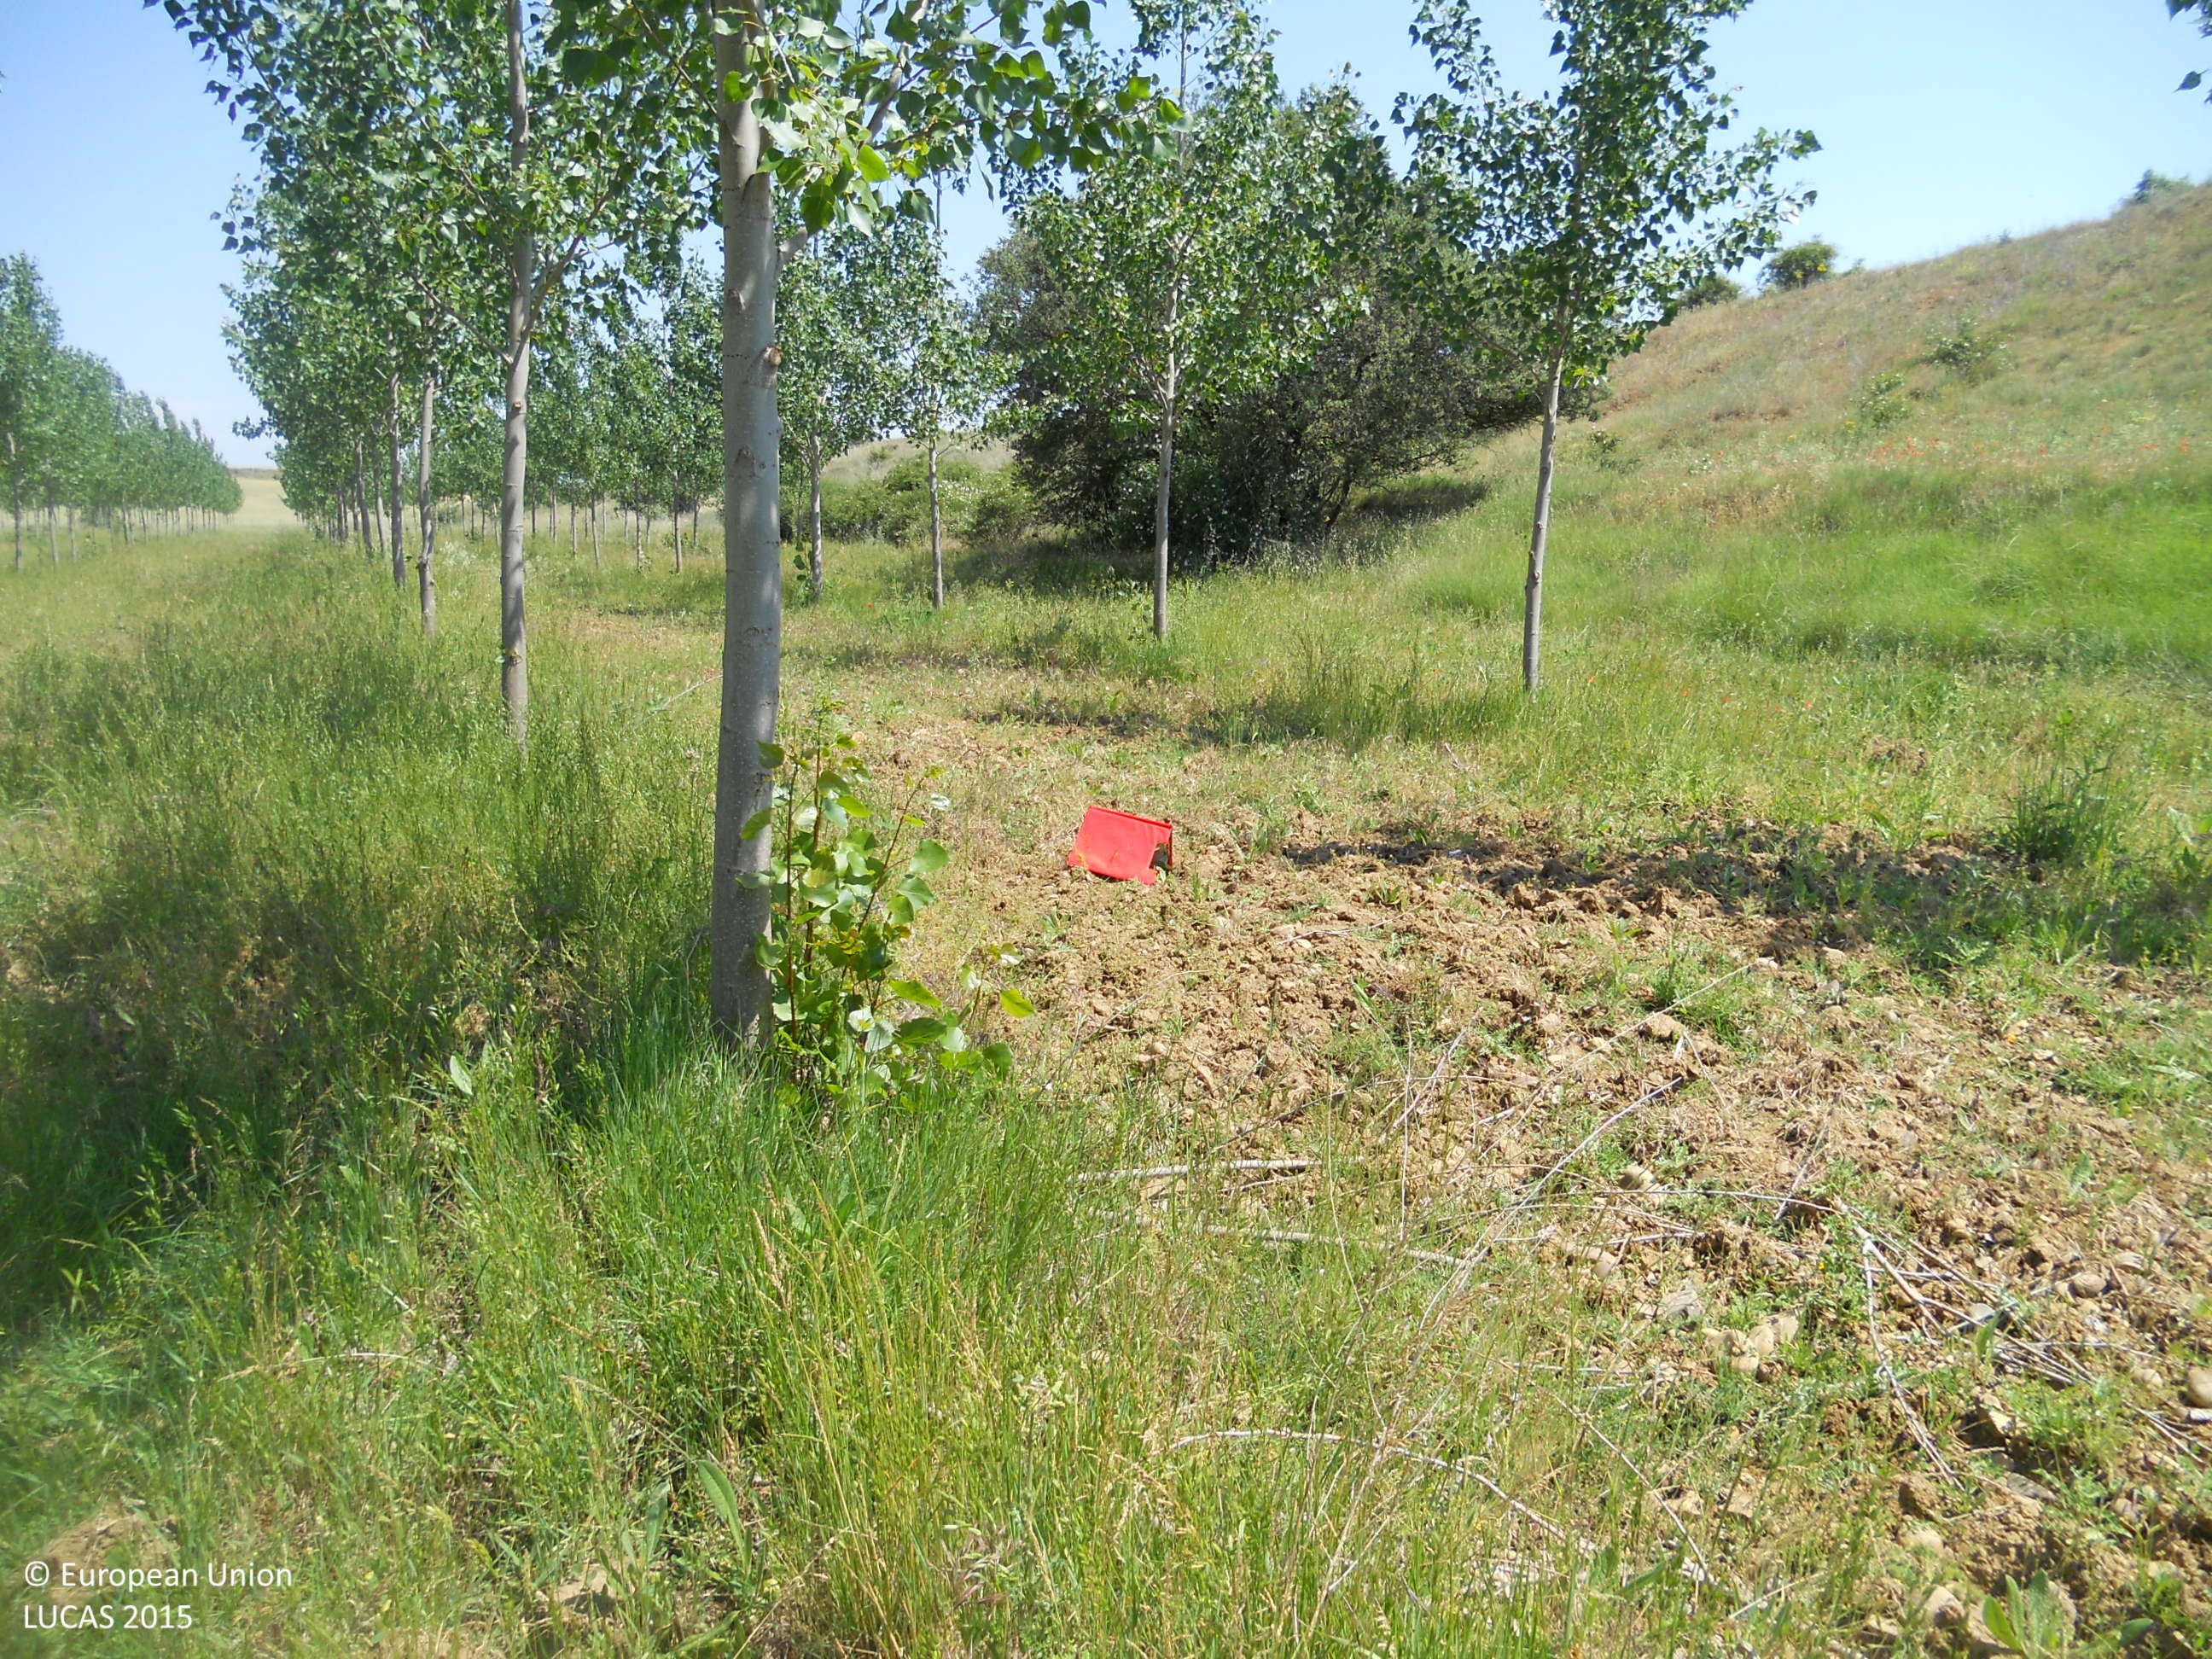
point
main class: Woodland
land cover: Broadleaved woodland
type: exotic forest
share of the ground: 10 - 25 %
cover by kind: herbaceous plants 75 %, broadleaved forest trees 20 %, shrubs 5 %
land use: Forestry
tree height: < 5 m
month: June
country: ES
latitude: 42.1977
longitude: -5.3096
